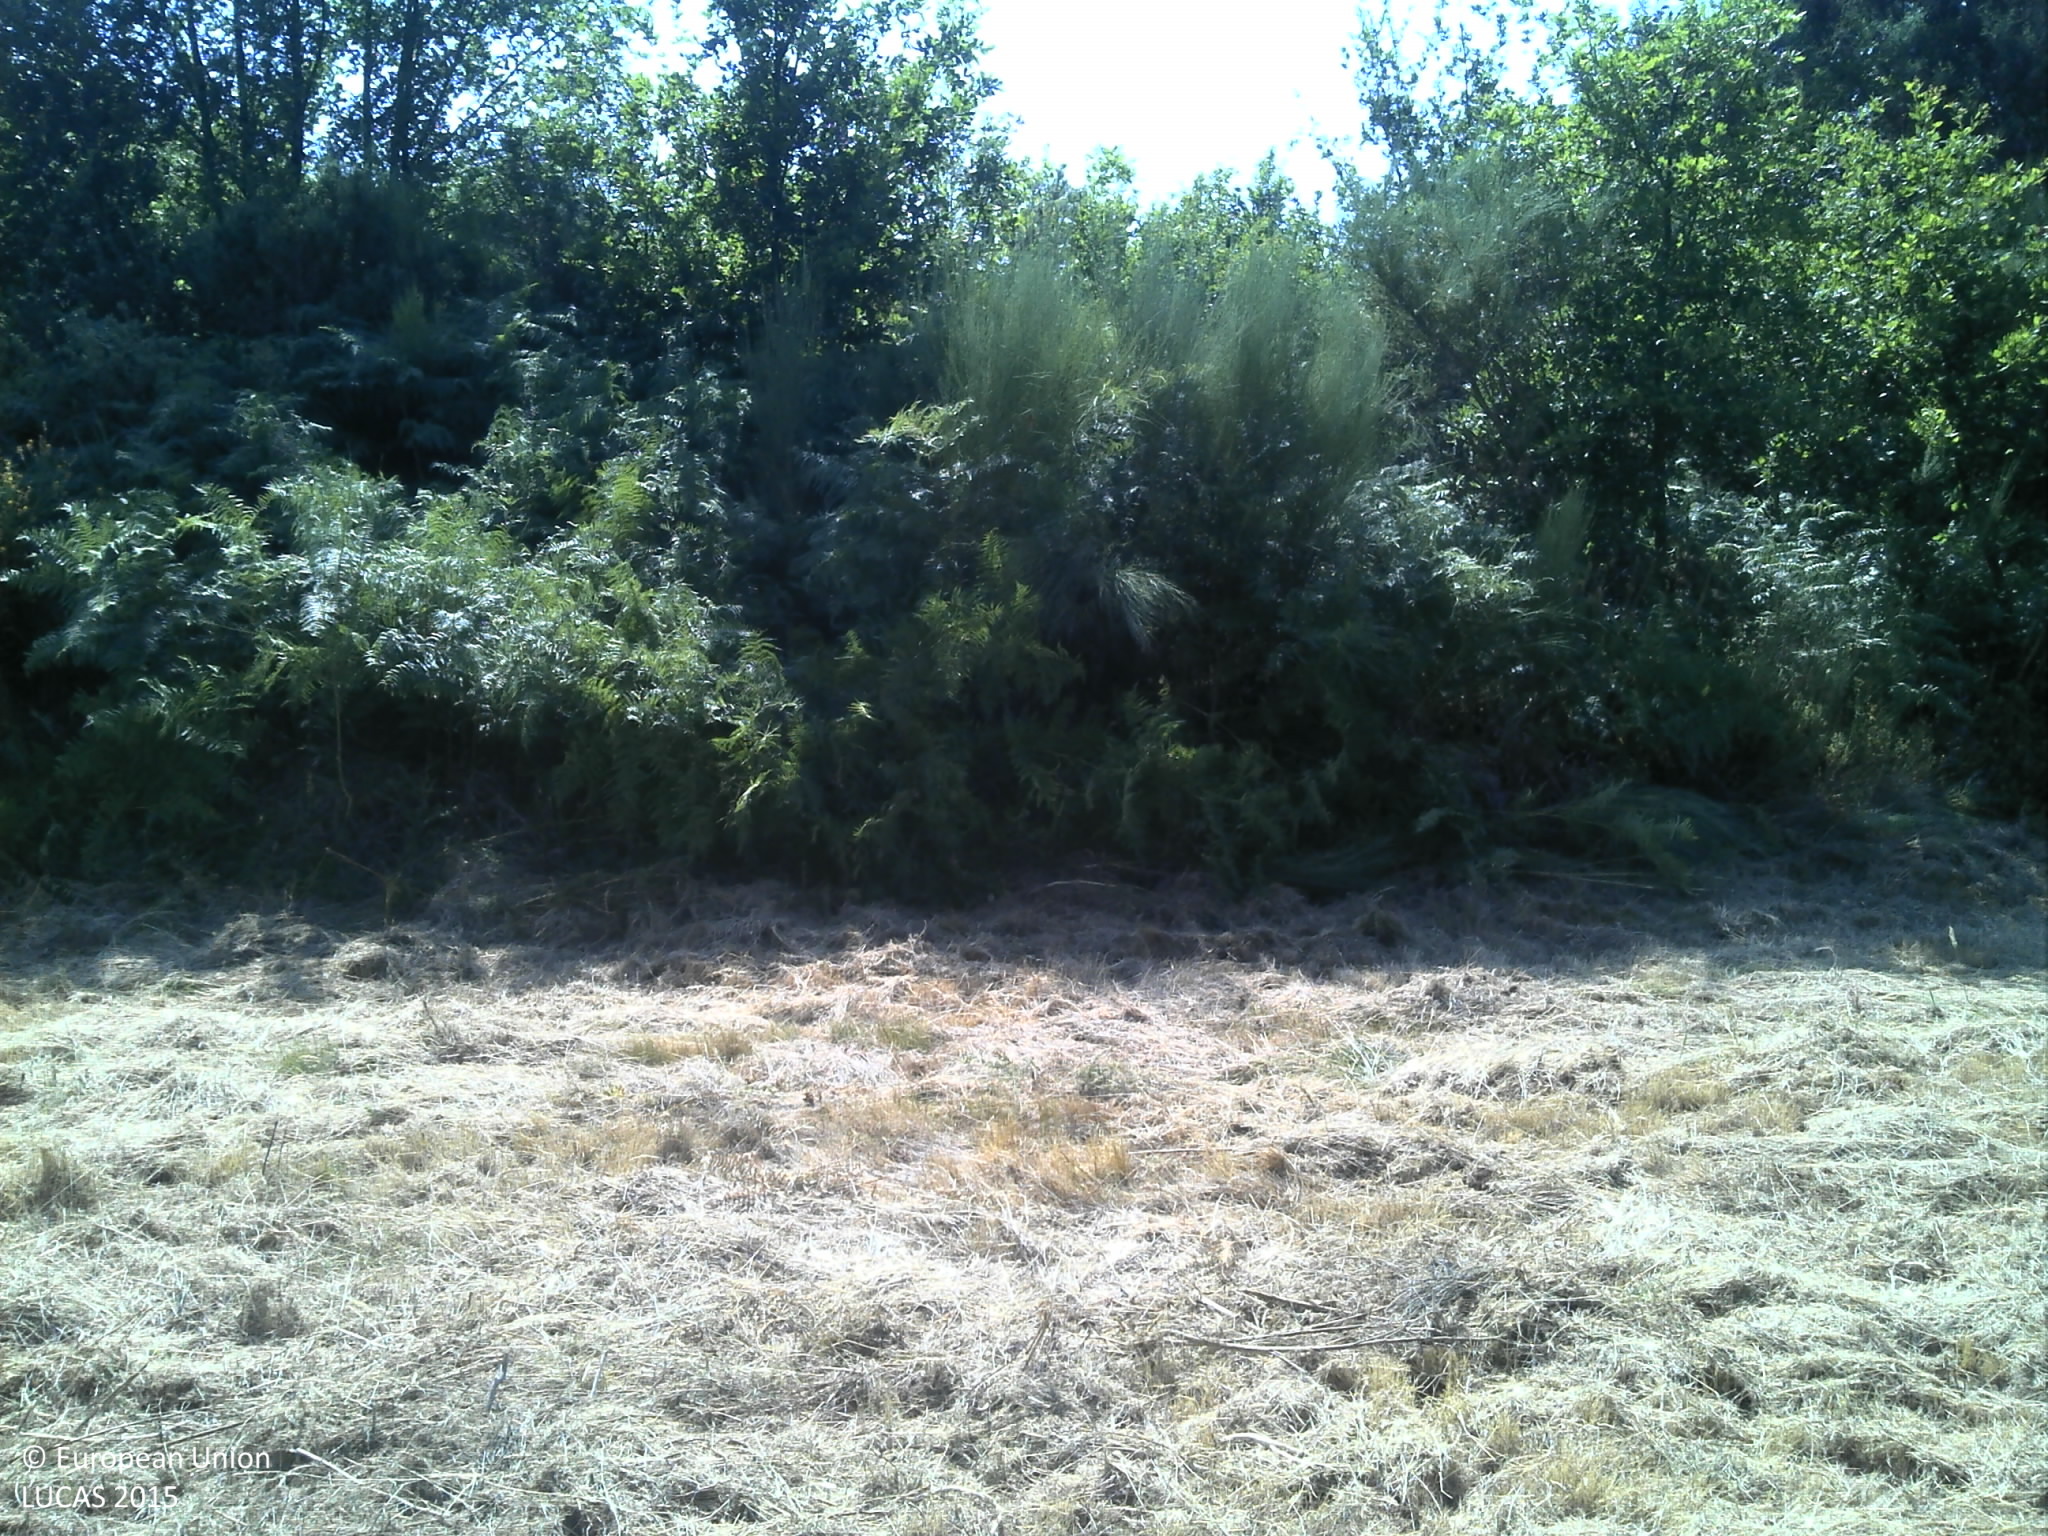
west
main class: Shrubland
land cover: Shrubland without tree cover
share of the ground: > 75 %
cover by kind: shrubs 85 %, unconsolidated bare surface 10 %, consolidated bare surface 5 %
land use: Semi-natural and natural areas not in use
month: June
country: PT
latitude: 40.5118
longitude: -7.8828
